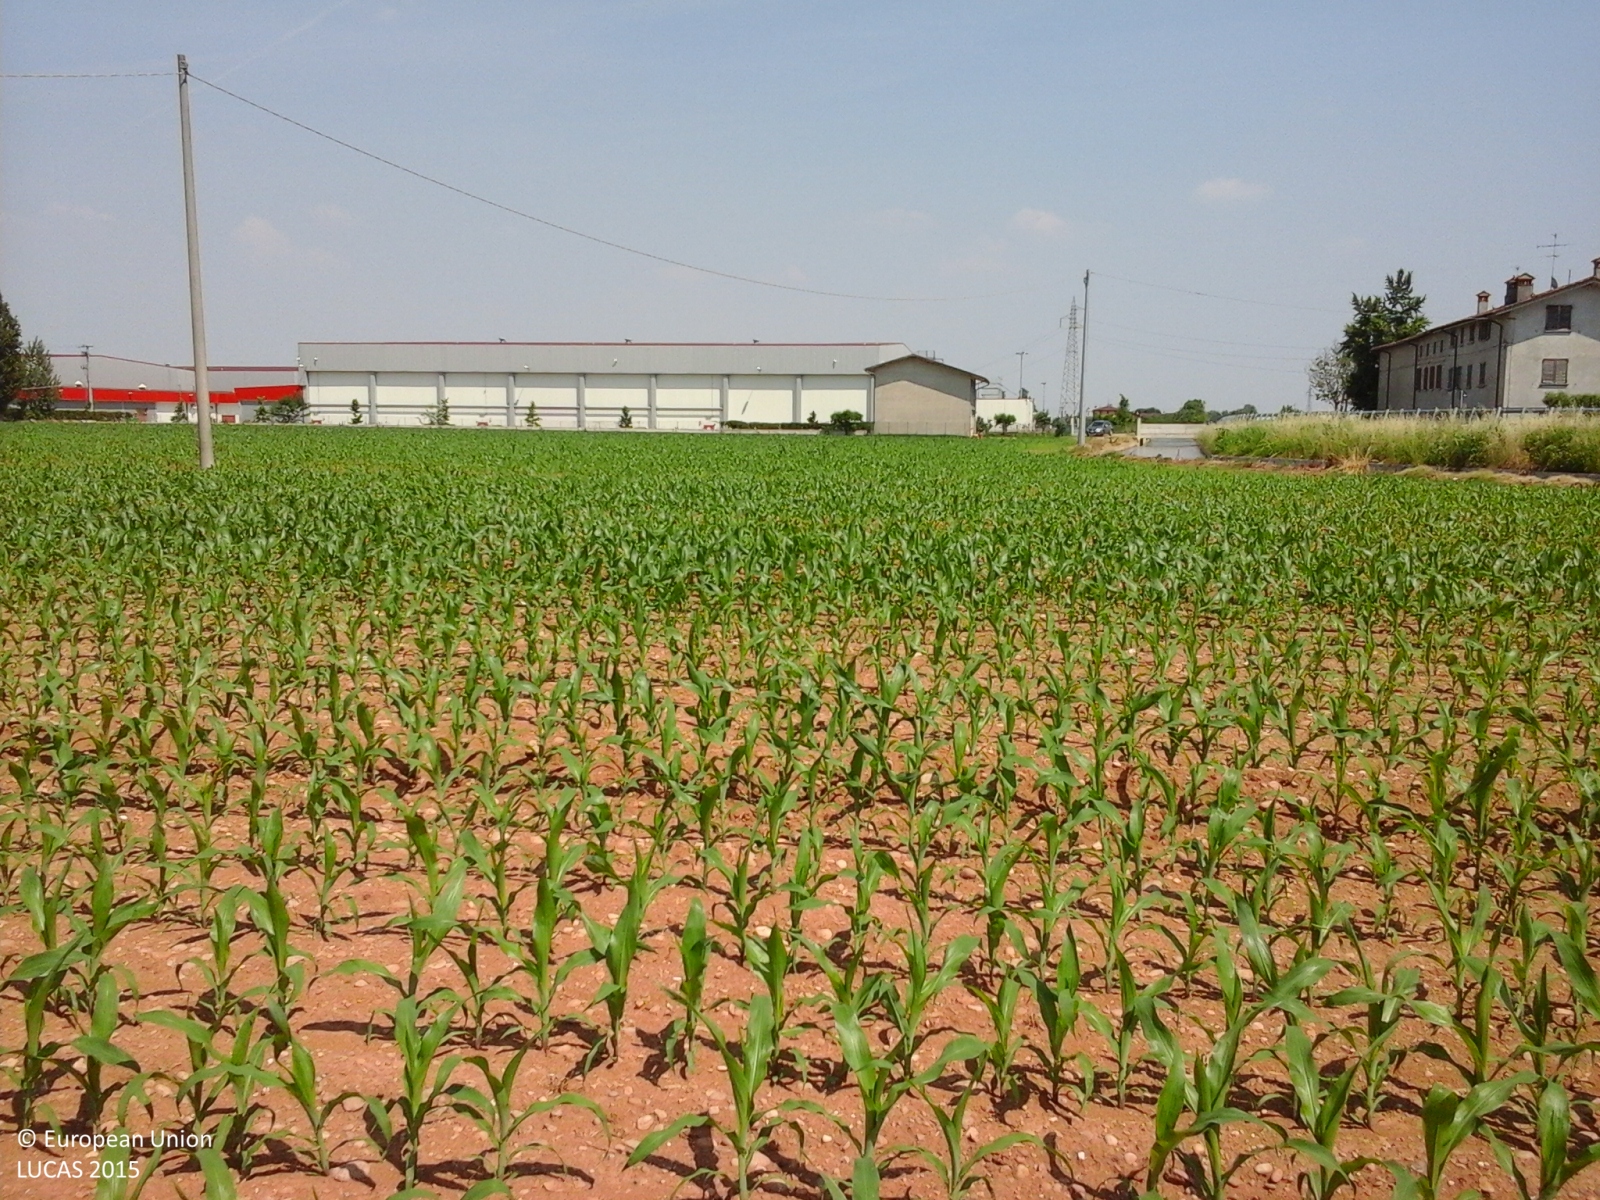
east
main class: Cropland
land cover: Maize
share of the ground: 50 - 75 %
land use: Agriculture (excluding fallow land and kitchen gardens)
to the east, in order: Maize; Electric lines; Maize; Managed hedges; Ditches and canals; Artificial constructions in urban areas
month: June
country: IT
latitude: 45.5044
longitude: 9.9106
